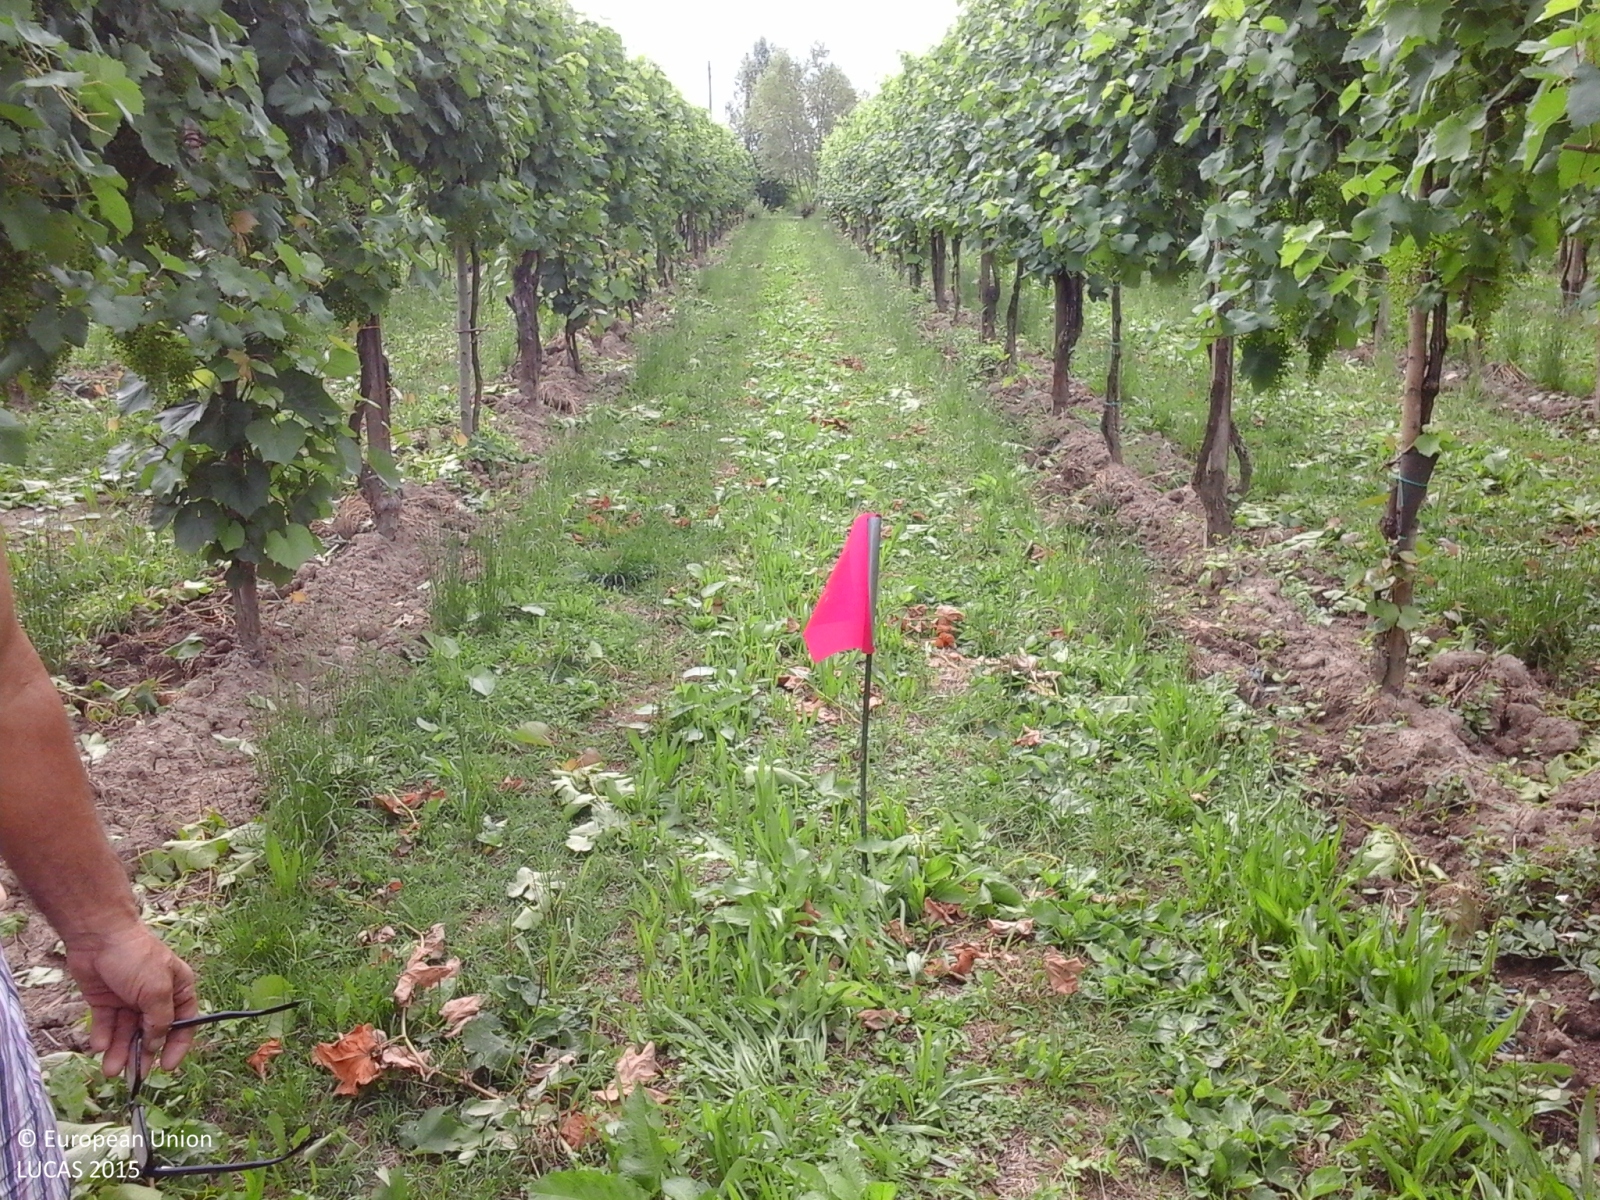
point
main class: Cropland
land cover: Vineyards
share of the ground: 25 - 50 %
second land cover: Grassland without tree/shrub cover
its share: > 75 %
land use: Agriculture (excluding fallow land and kitchen gardens)
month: June
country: IT
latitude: 45.6906
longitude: 12.5261
